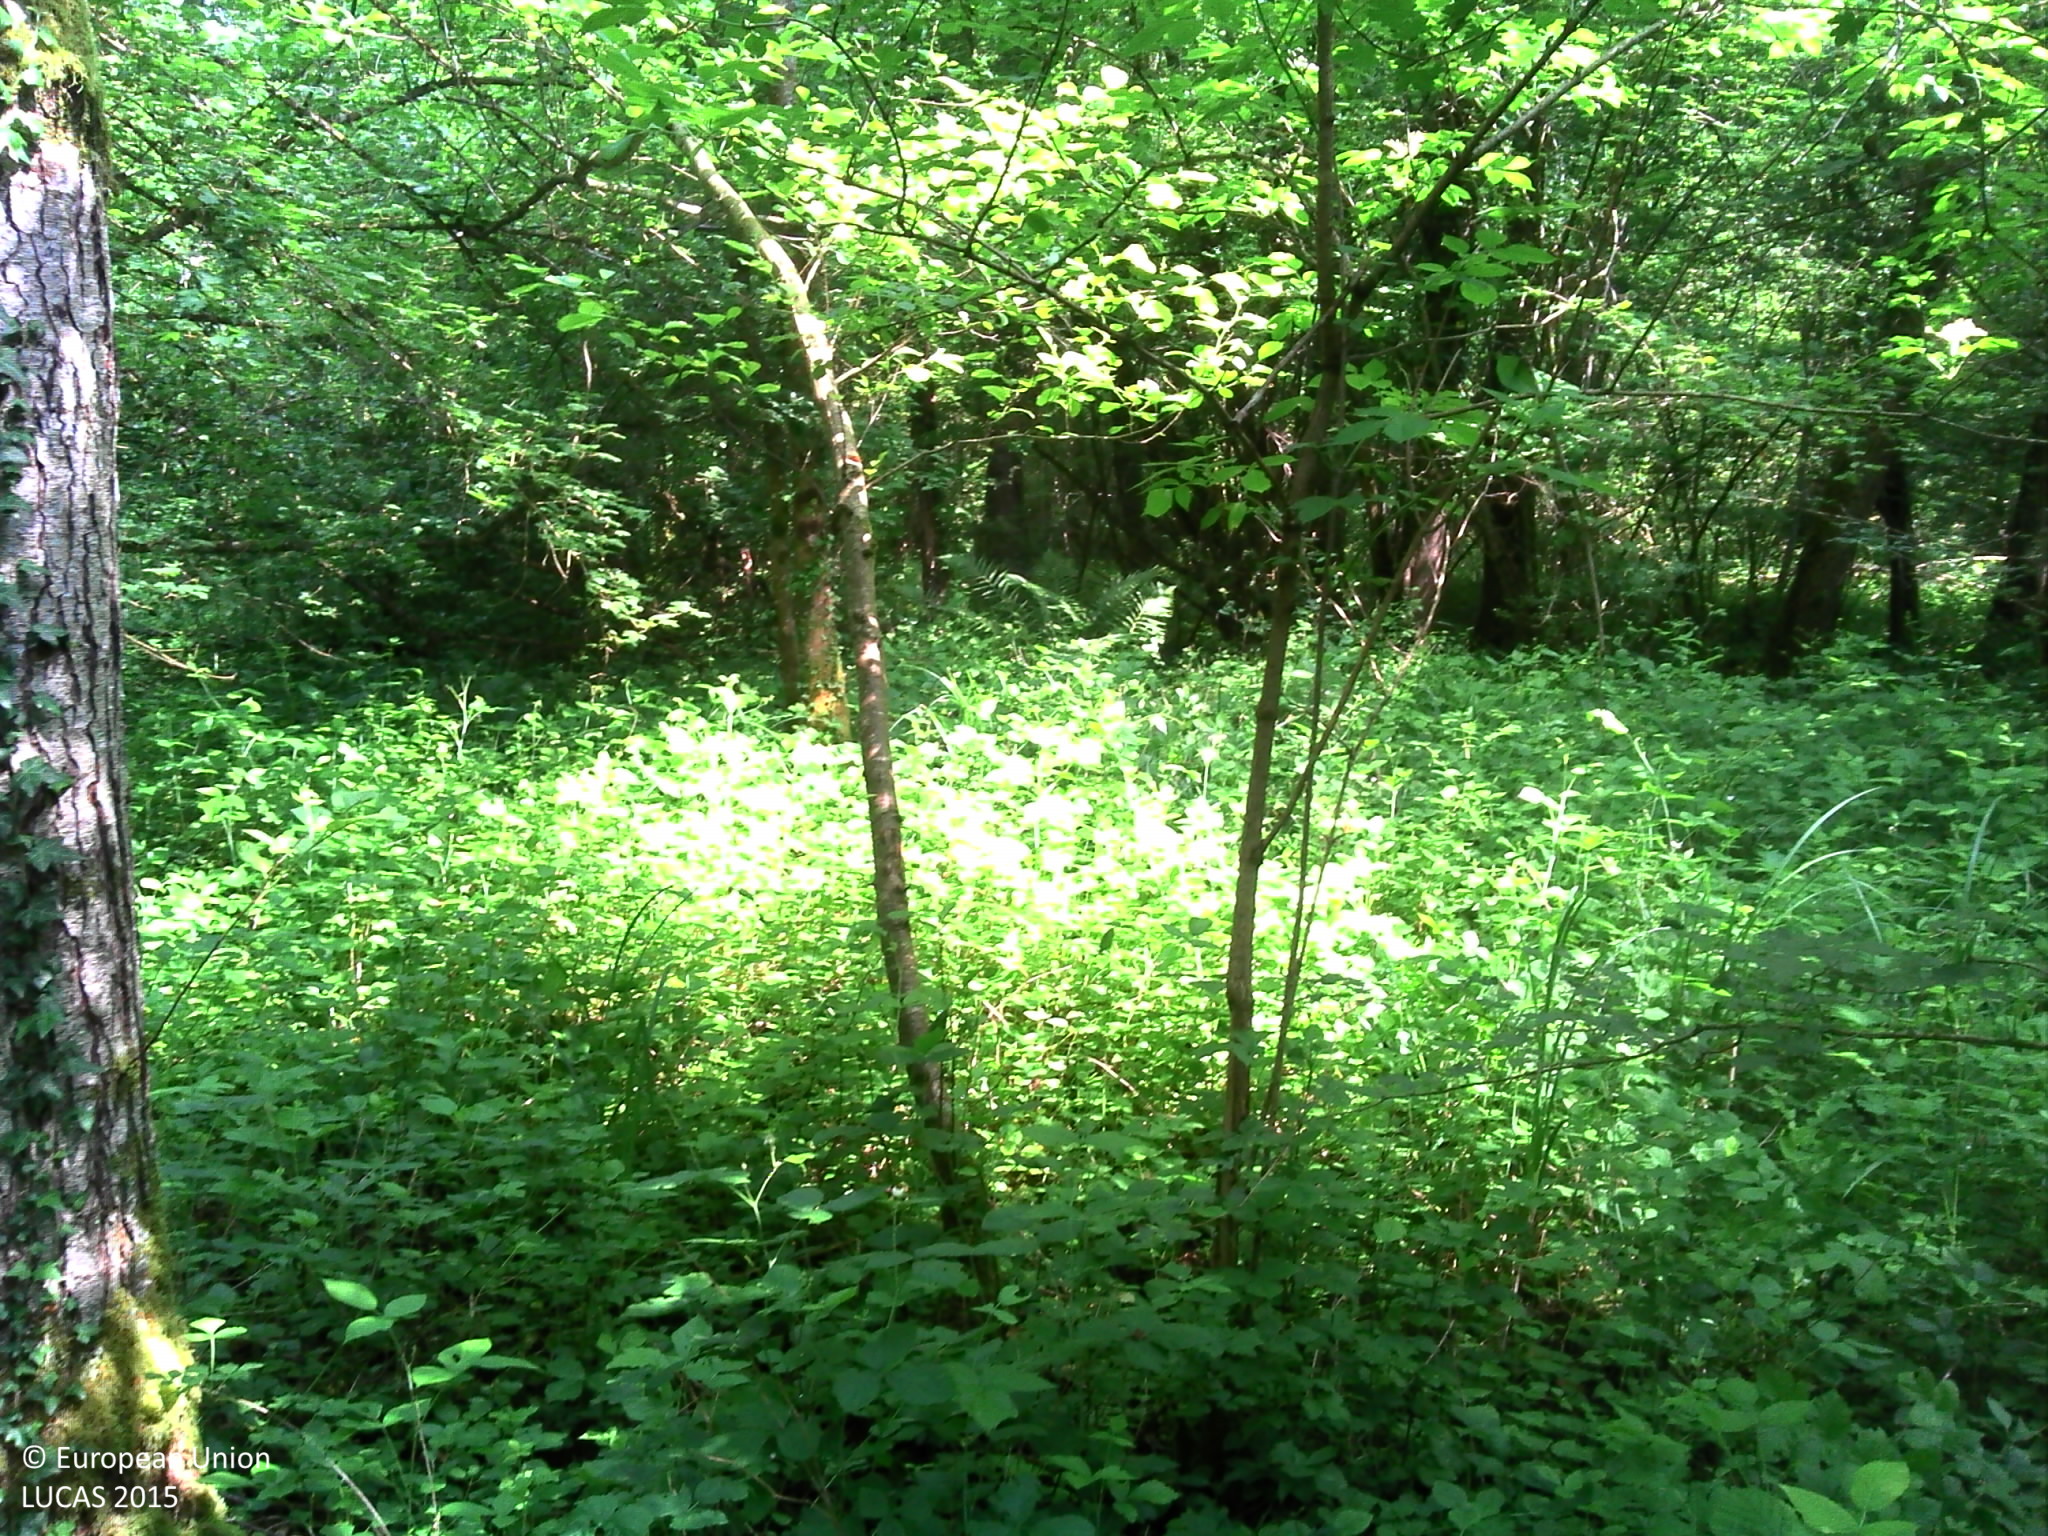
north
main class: Woodland
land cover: Broadleaved woodland
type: beech forest
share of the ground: > 75 %
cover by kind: broadleaved forest trees 90 %, herbaceous plants 10 %
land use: Forestry
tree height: > 5 m
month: June
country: FR
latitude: 47.9045
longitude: 6.1614
